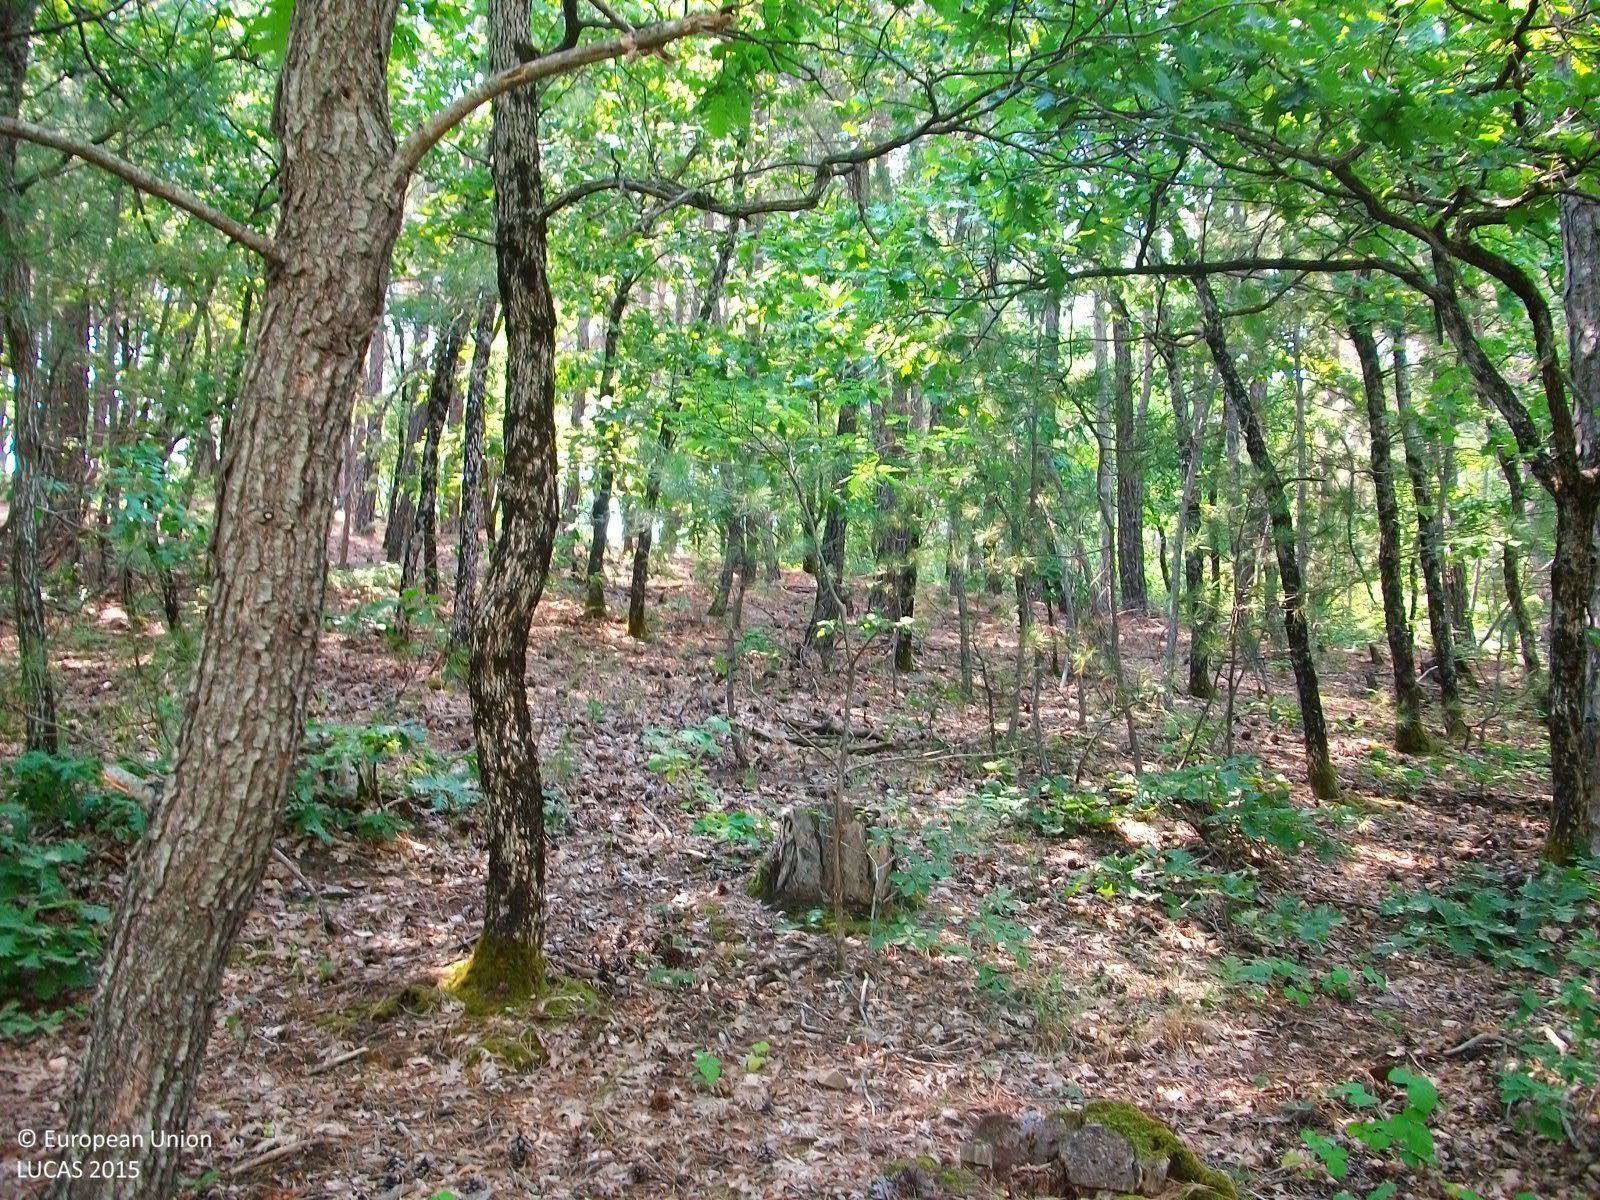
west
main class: Woodland
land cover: Pine dominated mixed woodland
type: coniferous forest of the mediterranean region
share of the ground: 50 - 75 %
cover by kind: coniferous forest trees 60 %, broadleaved forest trees 40 %
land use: Forestry
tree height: > 5 m
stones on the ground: < 10 %
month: July
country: GR
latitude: 41.1122
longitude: 26.1299
